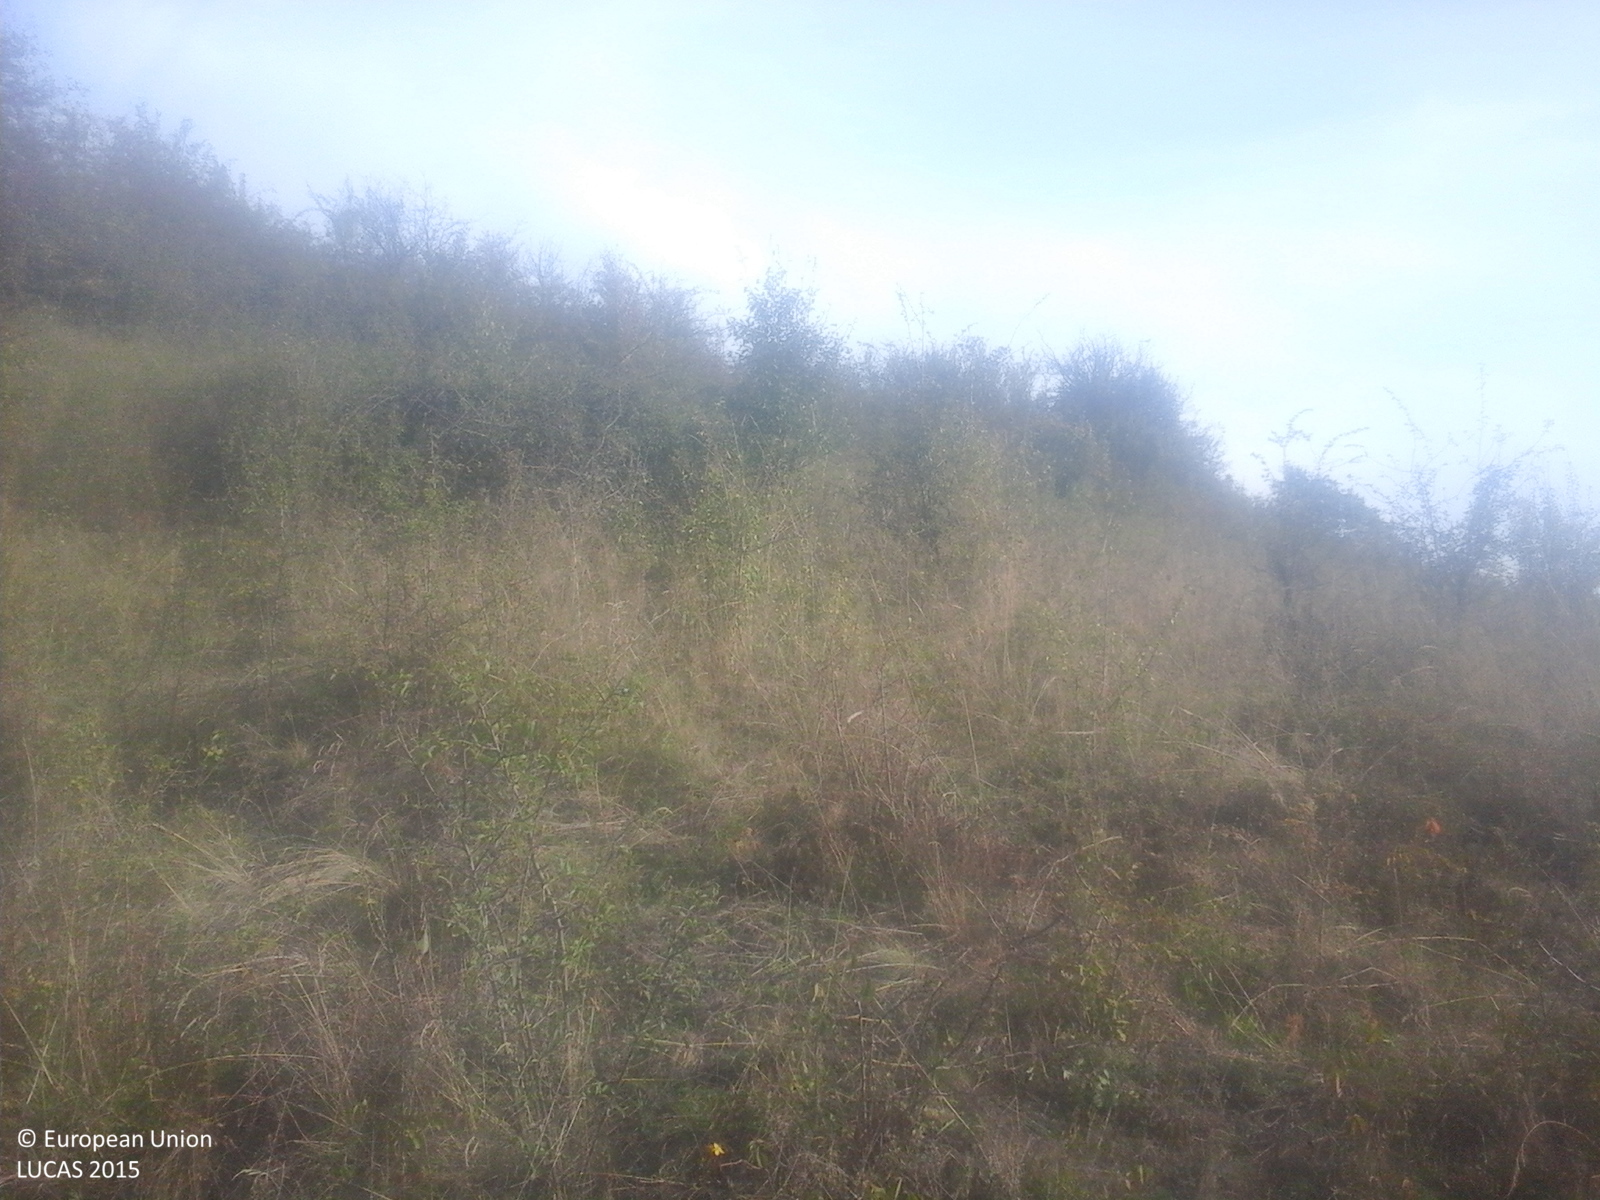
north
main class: Shrubland
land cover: Shrubland with sparse tree cover
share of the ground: > 75 %
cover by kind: shrubs 85 %, herbaceous plants 10 %, broadleaved forest trees 5 %
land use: Agriculture (excluding fallow land and kitchen gardens)
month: September
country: RO
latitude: 47.0407
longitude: 23.5087
